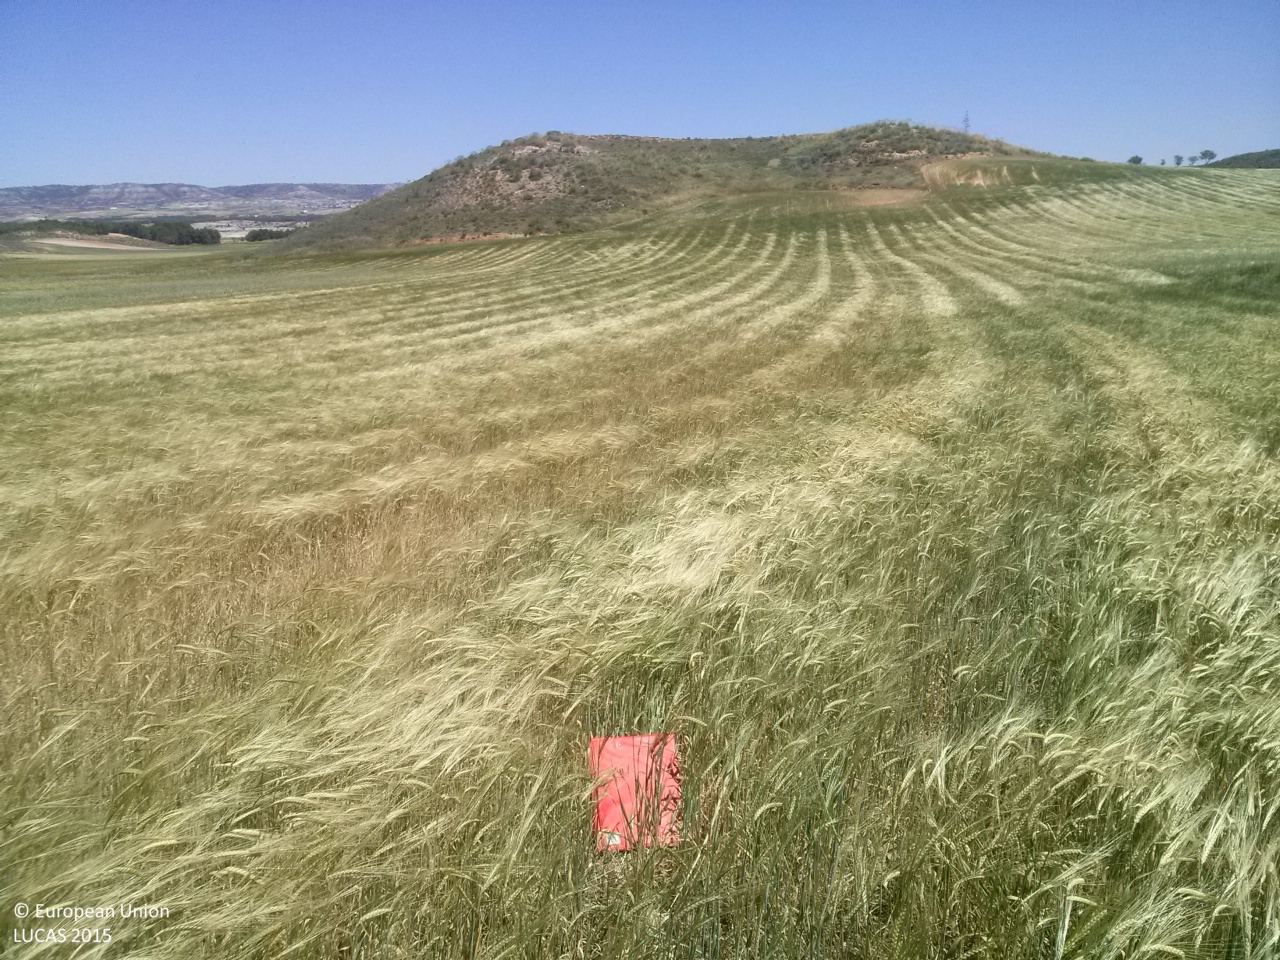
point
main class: Cropland
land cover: Barley
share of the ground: > 75 %
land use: Agriculture (excluding fallow land and kitchen gardens)
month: May
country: ES
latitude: 40.3282
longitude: -2.7481
